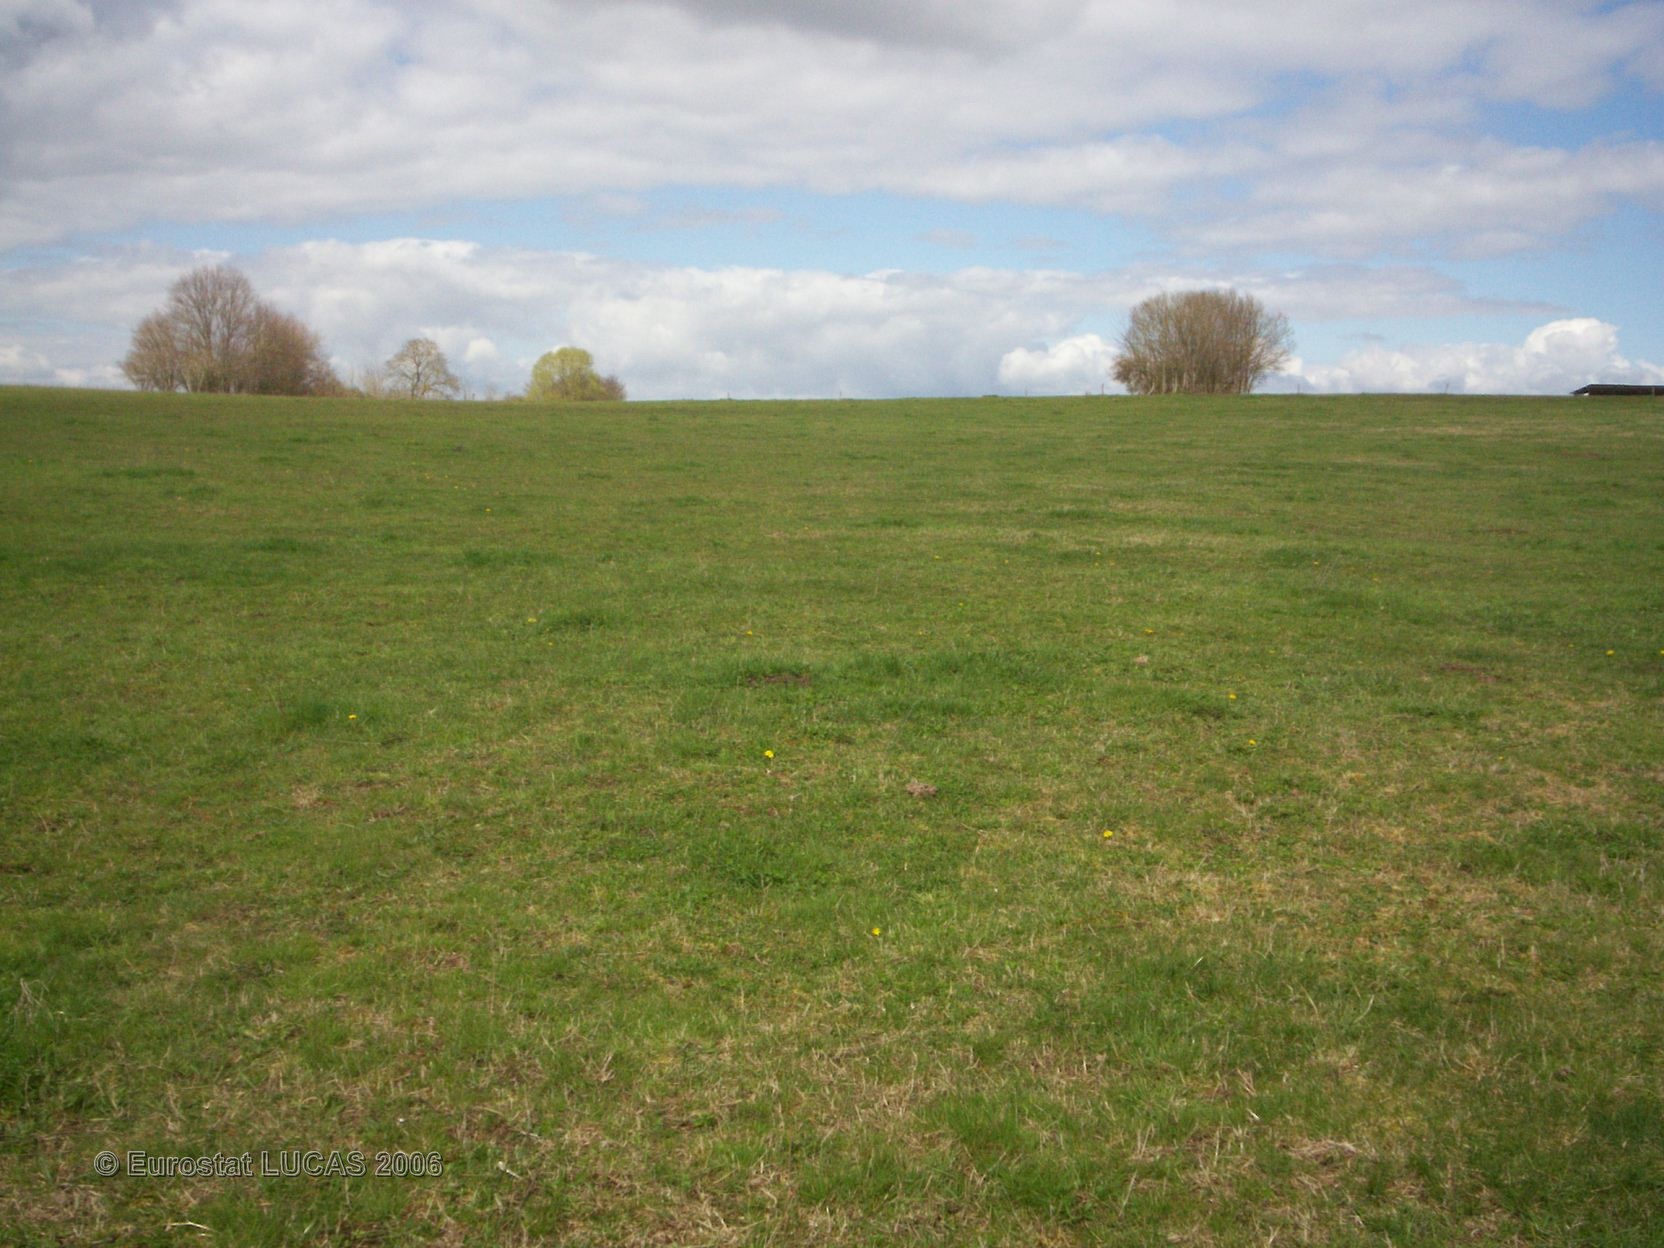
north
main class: Grassland
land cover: Grassland without tree/shrub cover
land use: Agriculture (excluding fallow land and kitchen gardens)
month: April
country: FR
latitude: 46.9219
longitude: 3.0756
